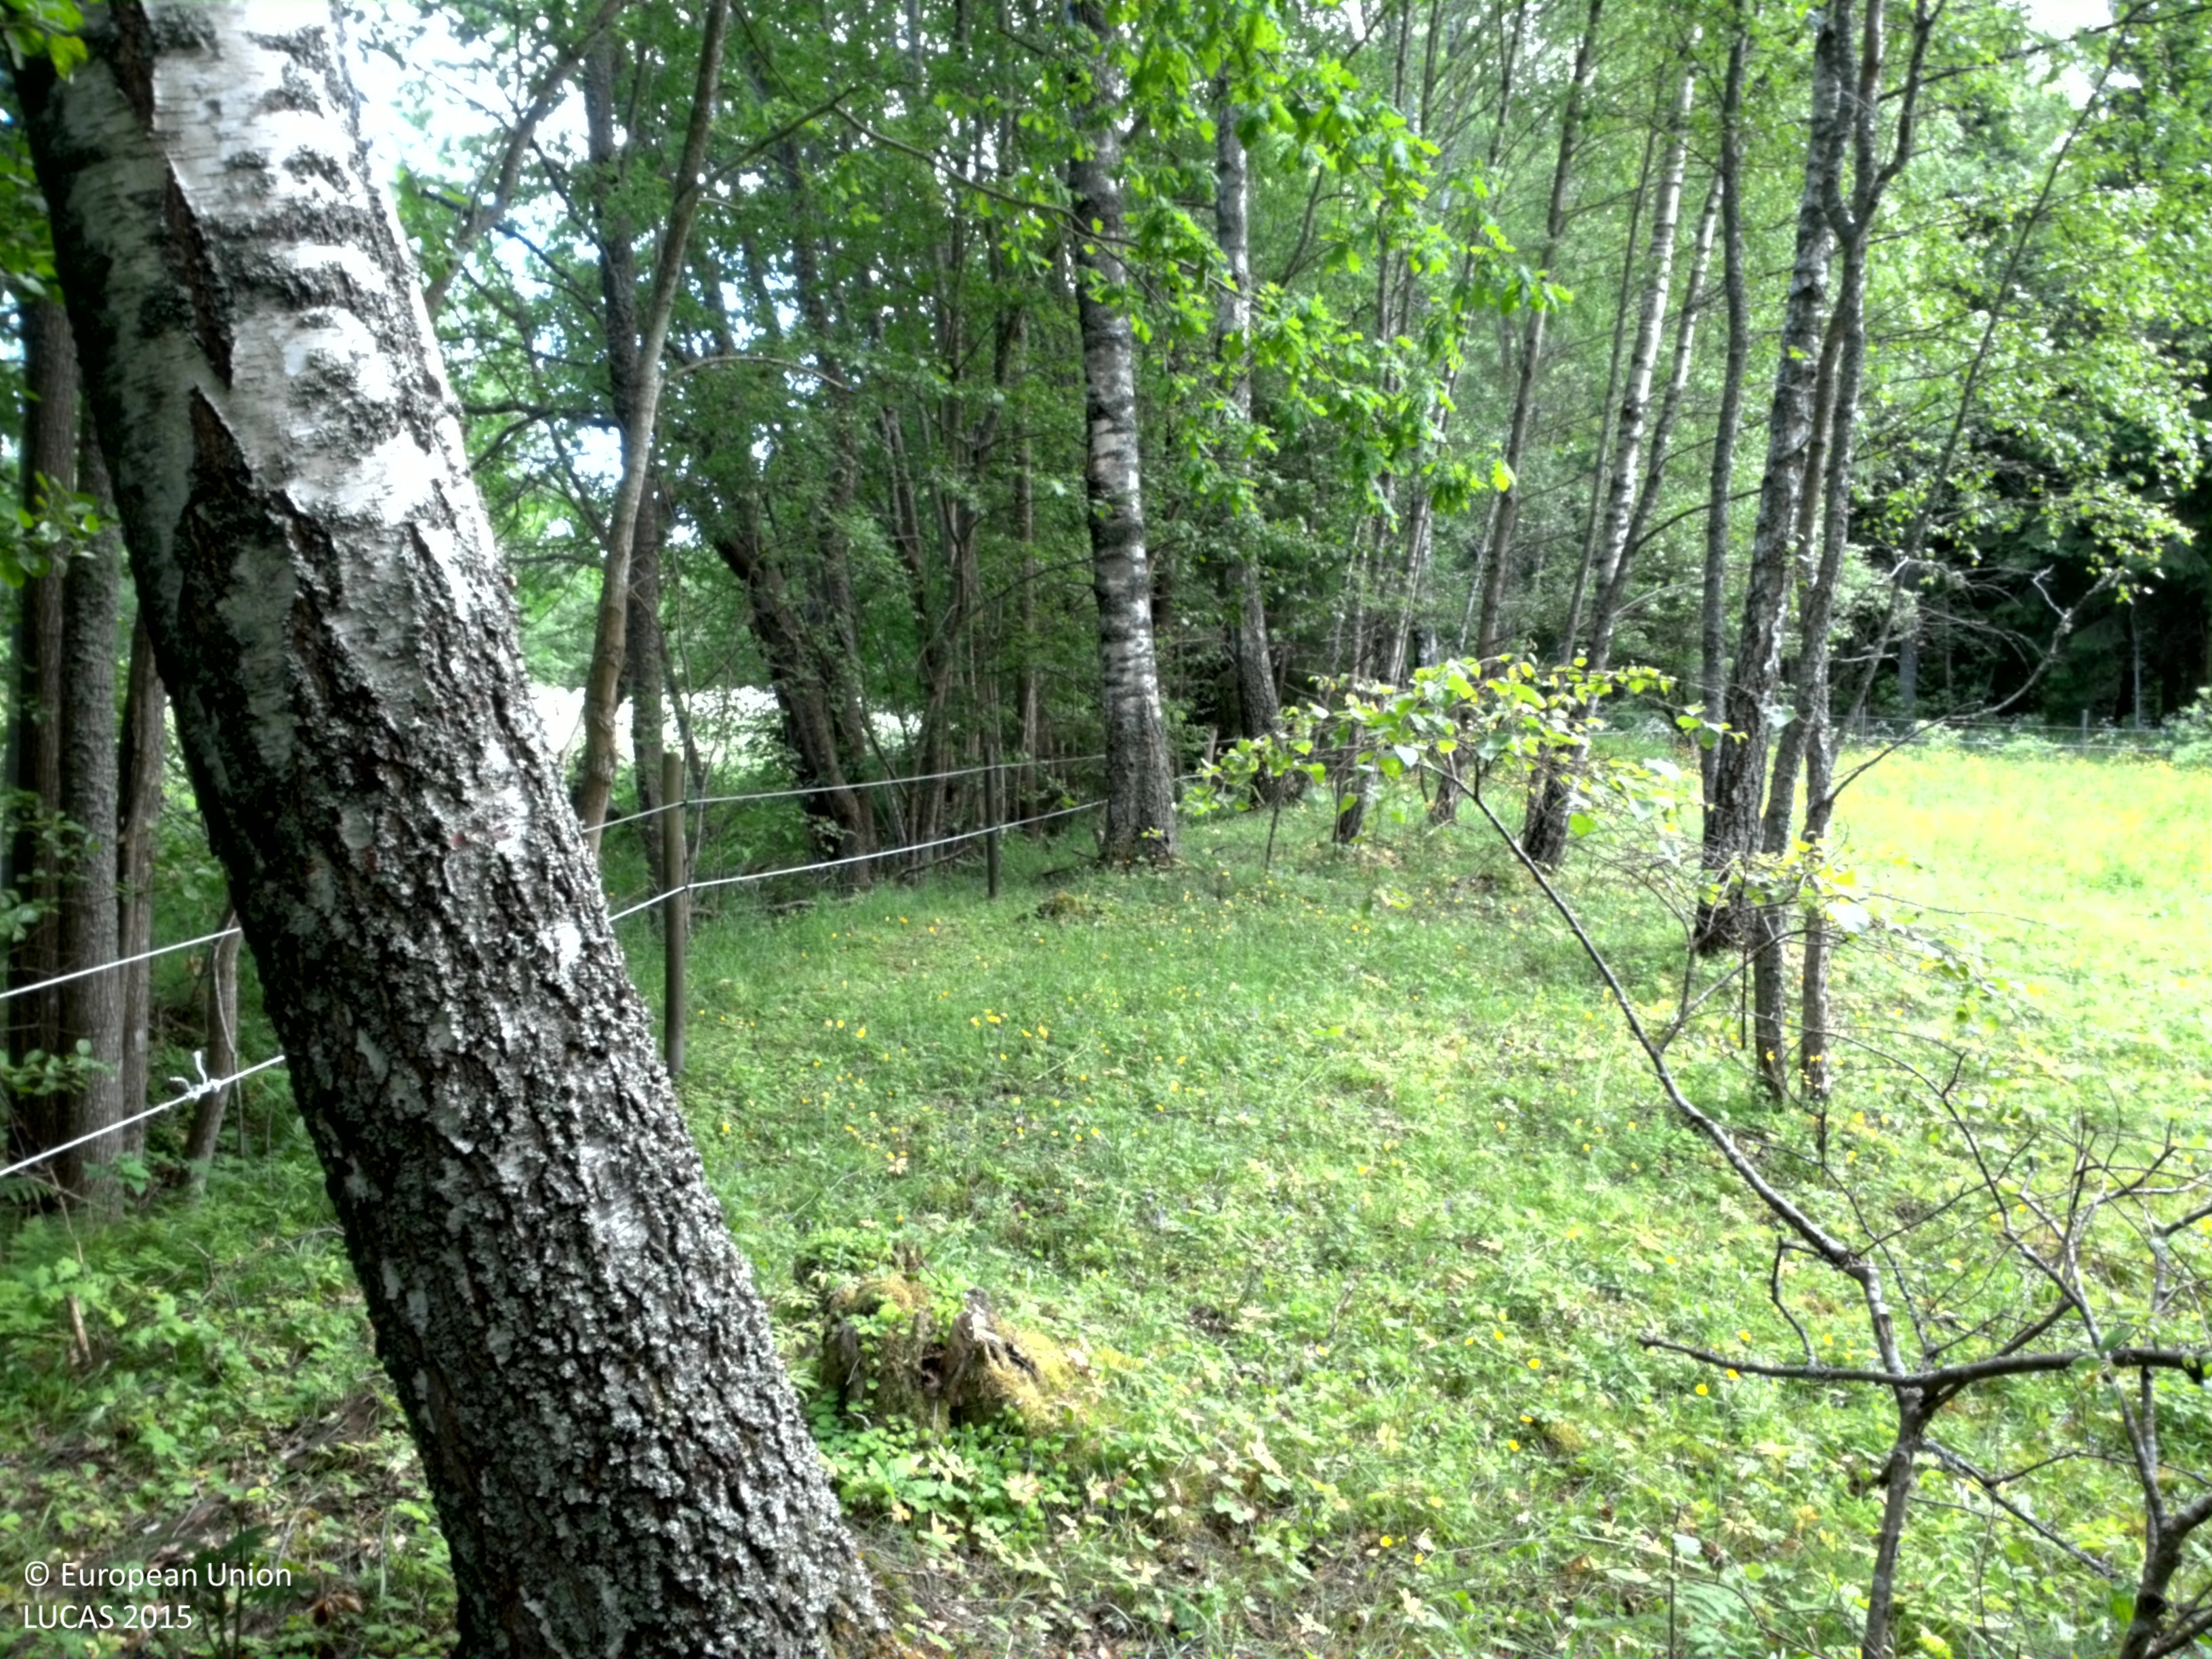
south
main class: Woodland
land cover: Broadleaved woodland
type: hemiboreal forest and nemoral coniferous forest and mixed broadleaved-coniferous forest
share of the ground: > 75 %
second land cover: Grassland without tree/shrub cover
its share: 10 - 25 %
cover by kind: broadleaved forest trees 80 %, herbaceous plants 20 %
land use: Forestry
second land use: Agriculture (excluding fallow land and kitchen gardens)
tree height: > 5 m
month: June
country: SE
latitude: 58.4180
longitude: 14.3933
